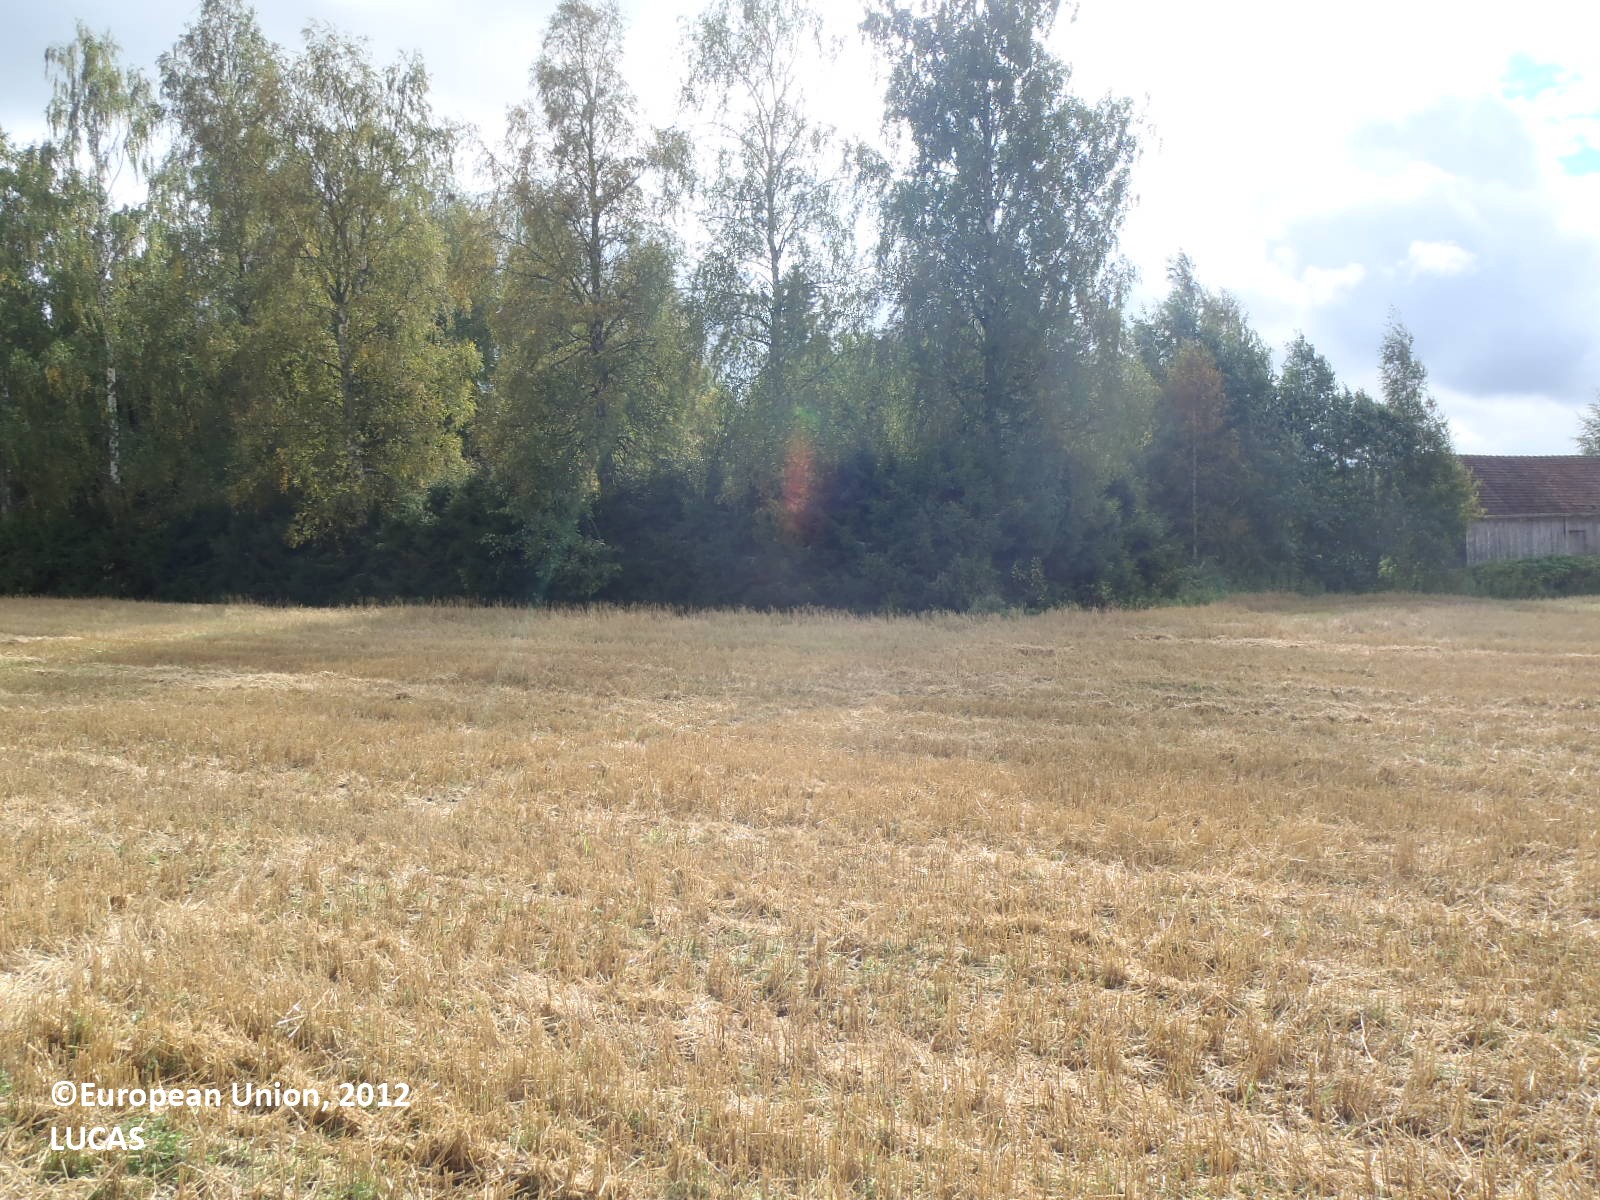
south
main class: Cropland
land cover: Barley
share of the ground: 50 - 75 %
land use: Agriculture (excluding fallow land and kitchen gardens)
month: September
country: FI
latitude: 61.0603
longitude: 22.7608
